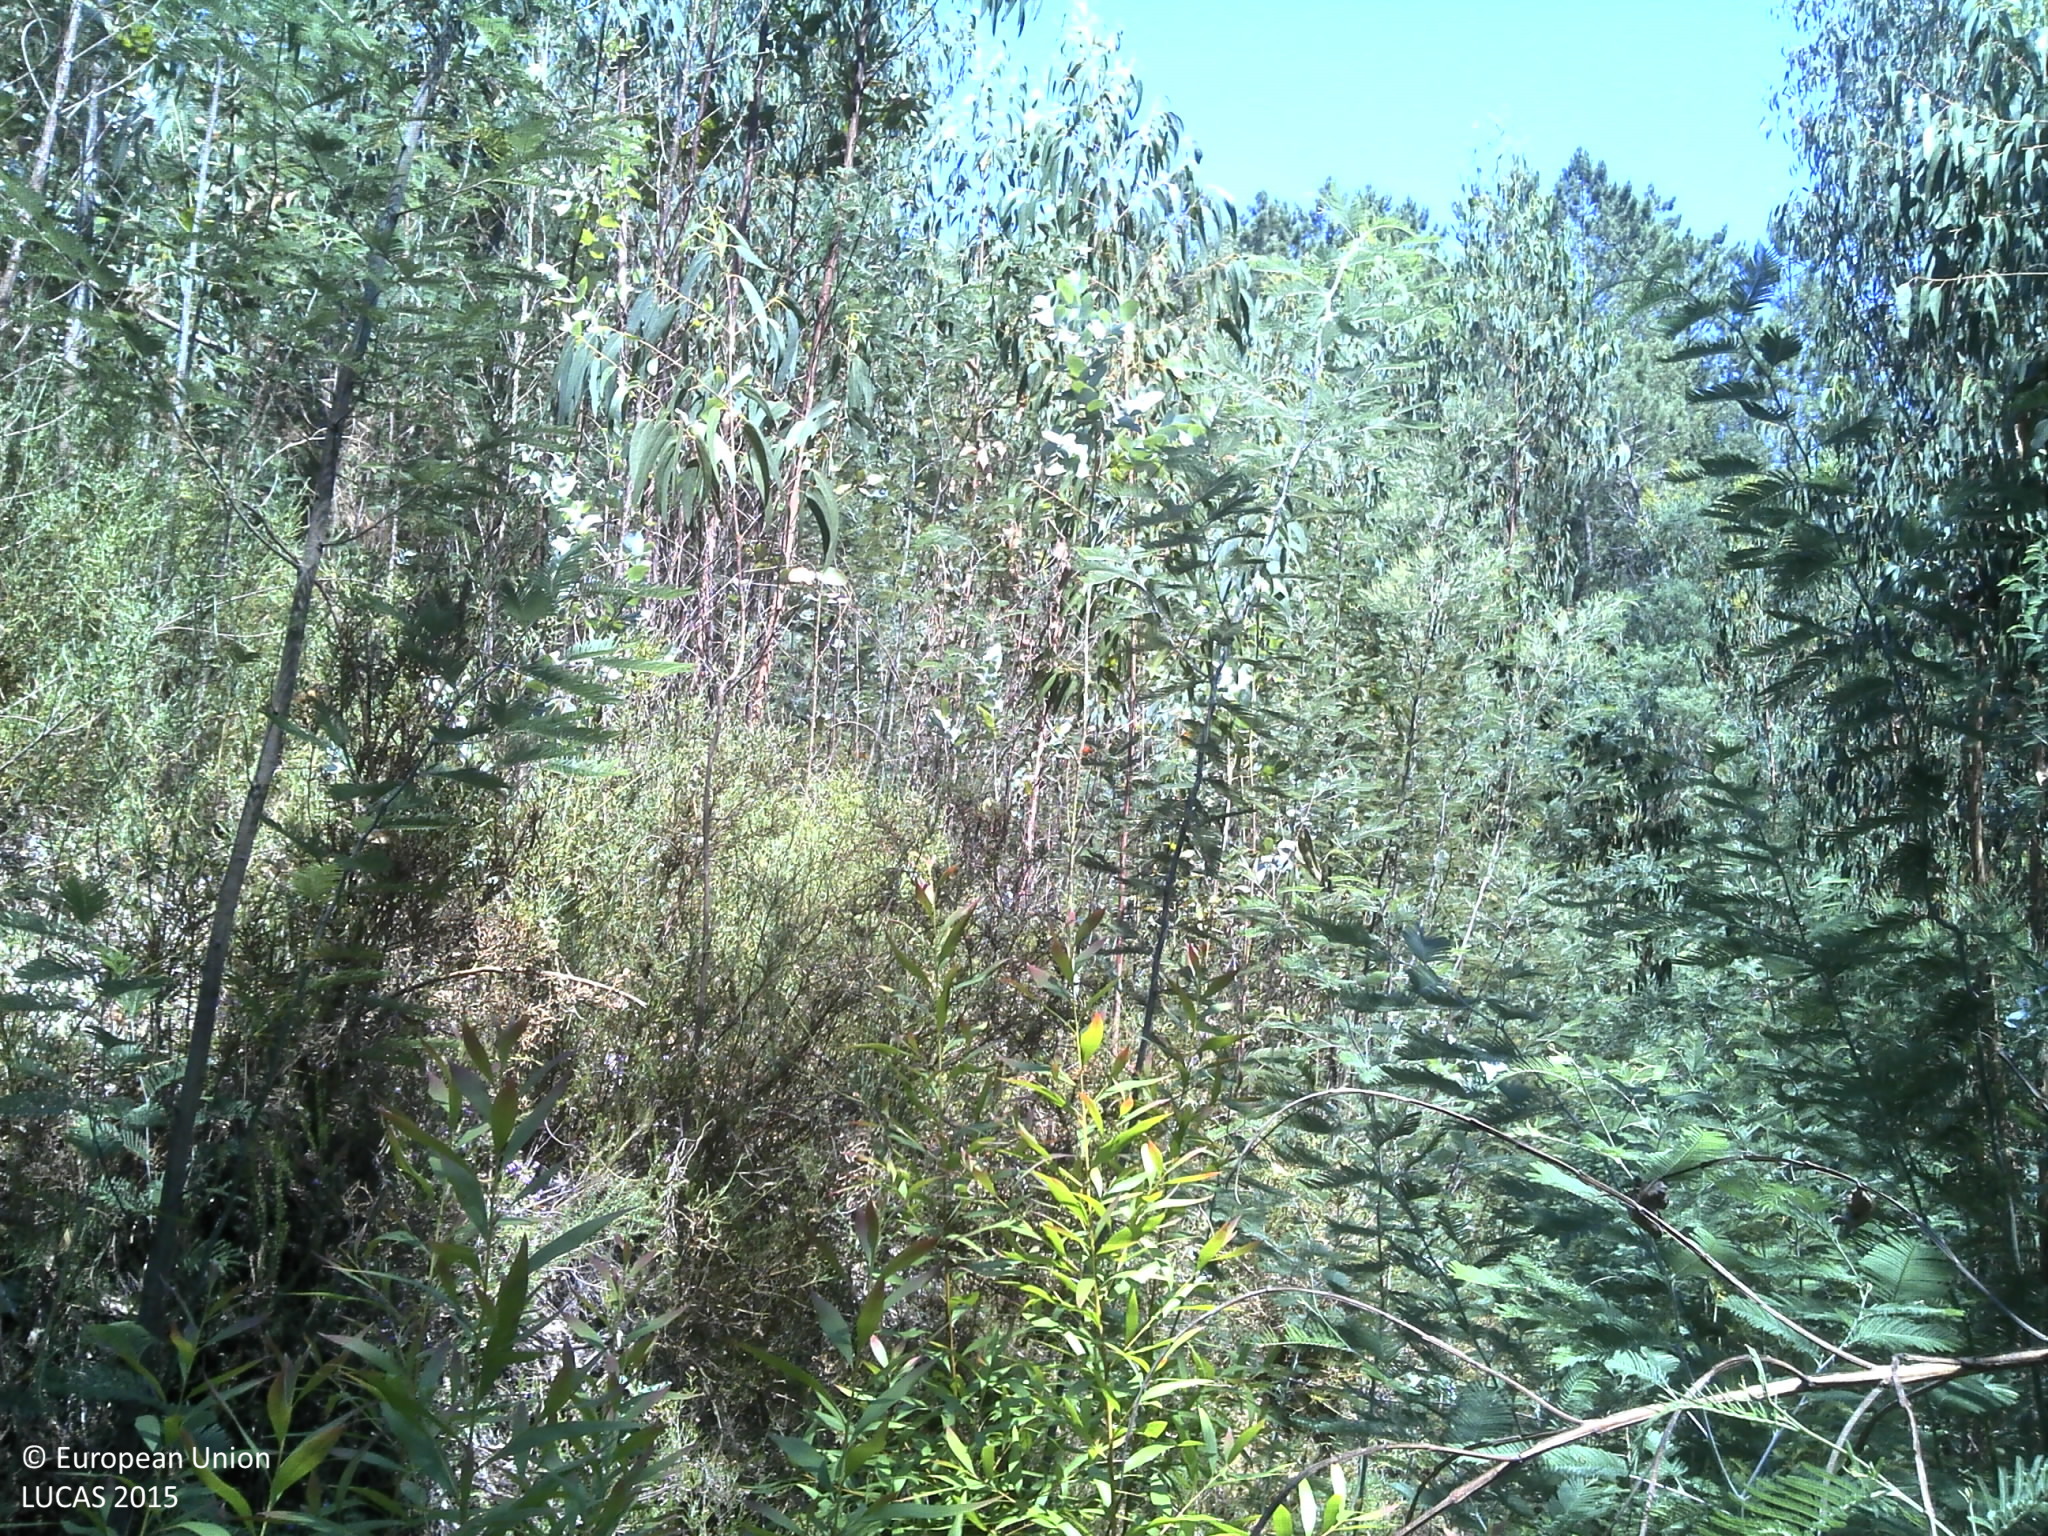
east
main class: Woodland
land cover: Broadleaved woodland
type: exotic forest
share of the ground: > 75 %
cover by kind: broadleaved forest trees 70 %, shrubs 20 %, unconsolidated bare surface 10 %
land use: Forestry
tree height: > 5 m
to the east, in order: Broadleaved woodland; Tracks; Broadleaved woodland; Shrubland with sparse tree cover; Tracks; Shrubland with sparse tree cover; Tracks; Shrubland without tree cover; Tracks
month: July
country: PT
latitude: 40.6970
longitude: -8.3747
